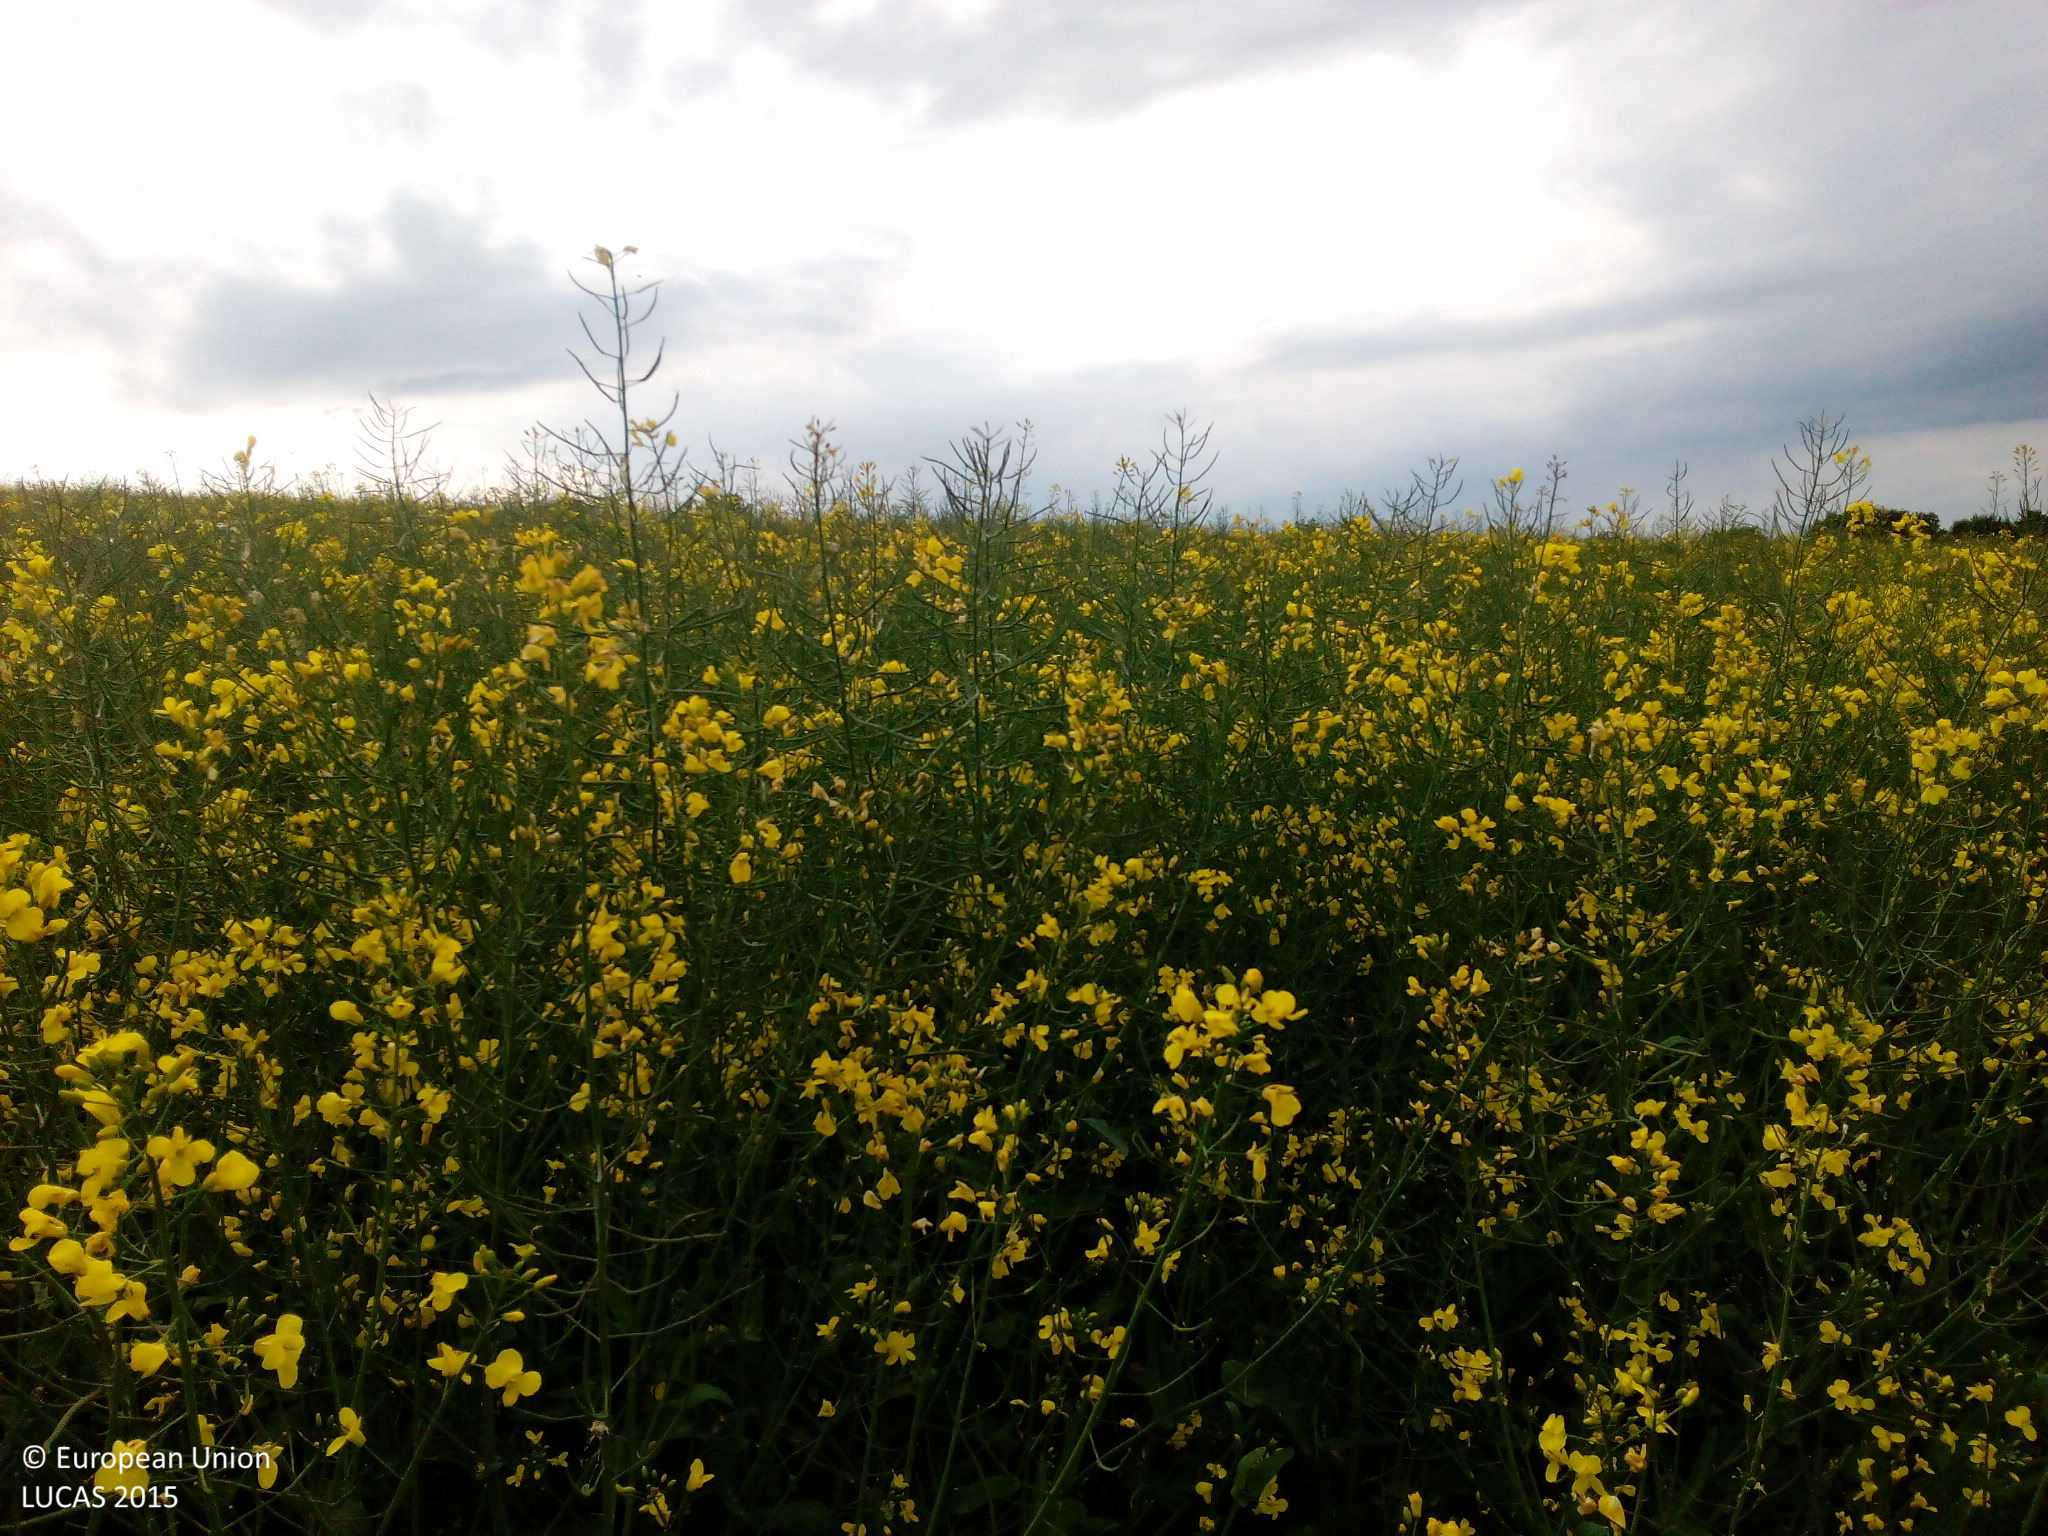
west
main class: Cropland
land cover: Rape and turnip rape
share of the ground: > 75 %
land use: Agriculture (excluding fallow land and kitchen gardens)
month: May
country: DE
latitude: 49.7594
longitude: 11.5960
